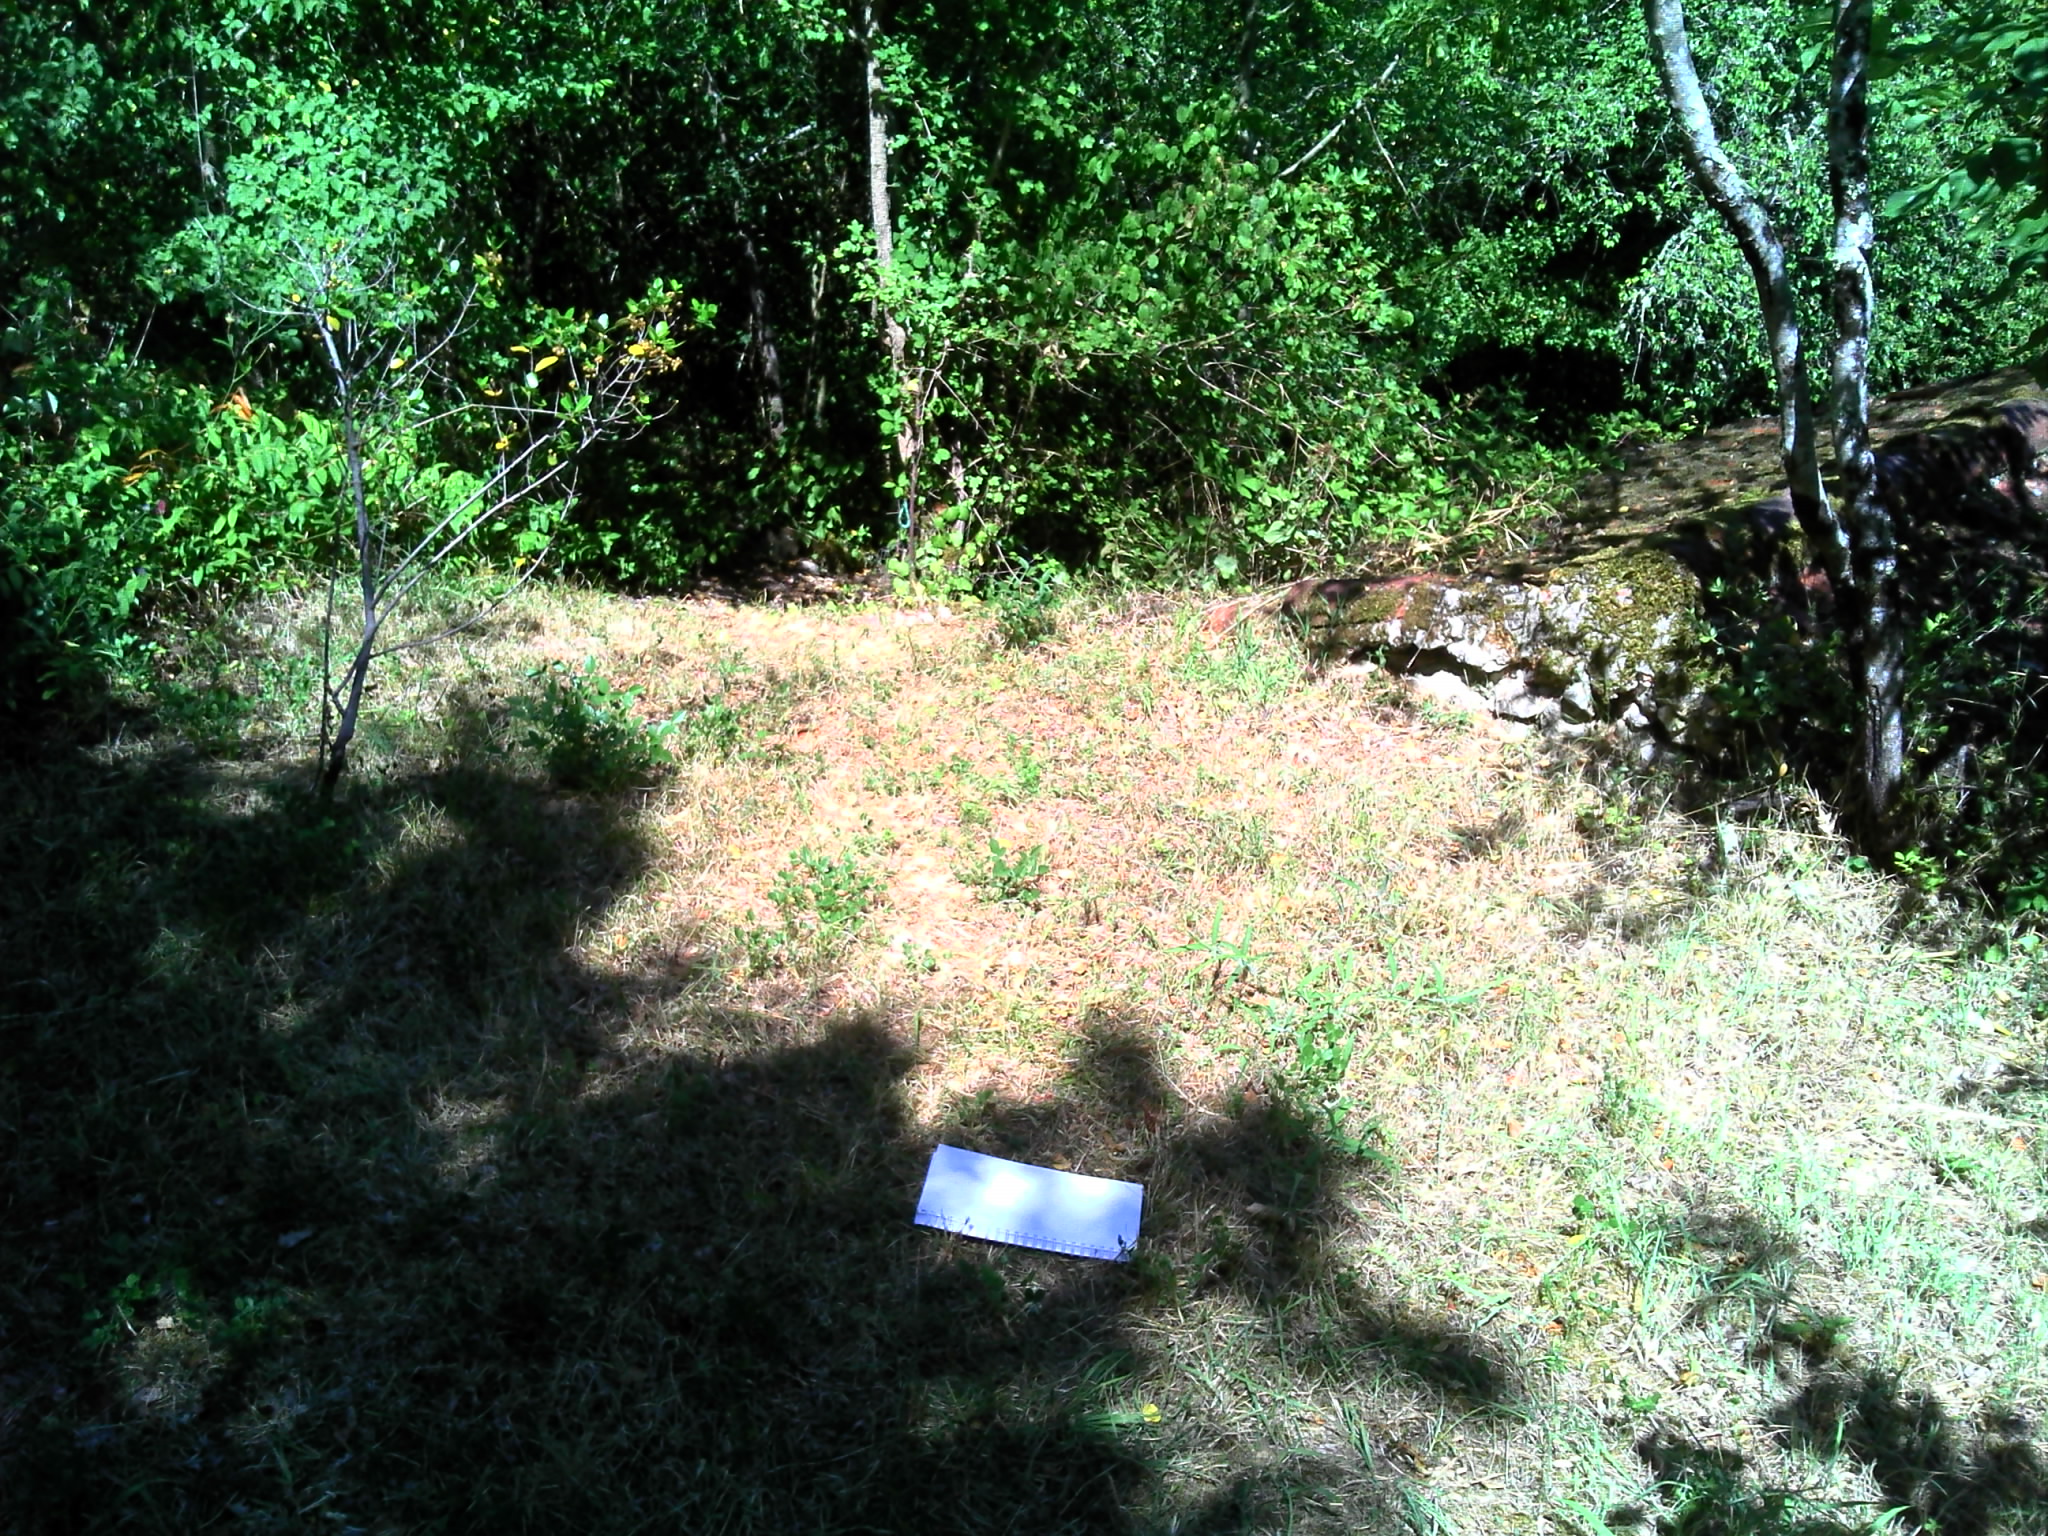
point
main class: Grassland
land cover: Grassland with sparse tree/shrub cover
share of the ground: > 75 %
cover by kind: herbaceous plants 95 %, broadleaved forest trees 5 %
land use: Residential
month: July
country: FR
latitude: 44.4687
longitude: 1.2355
